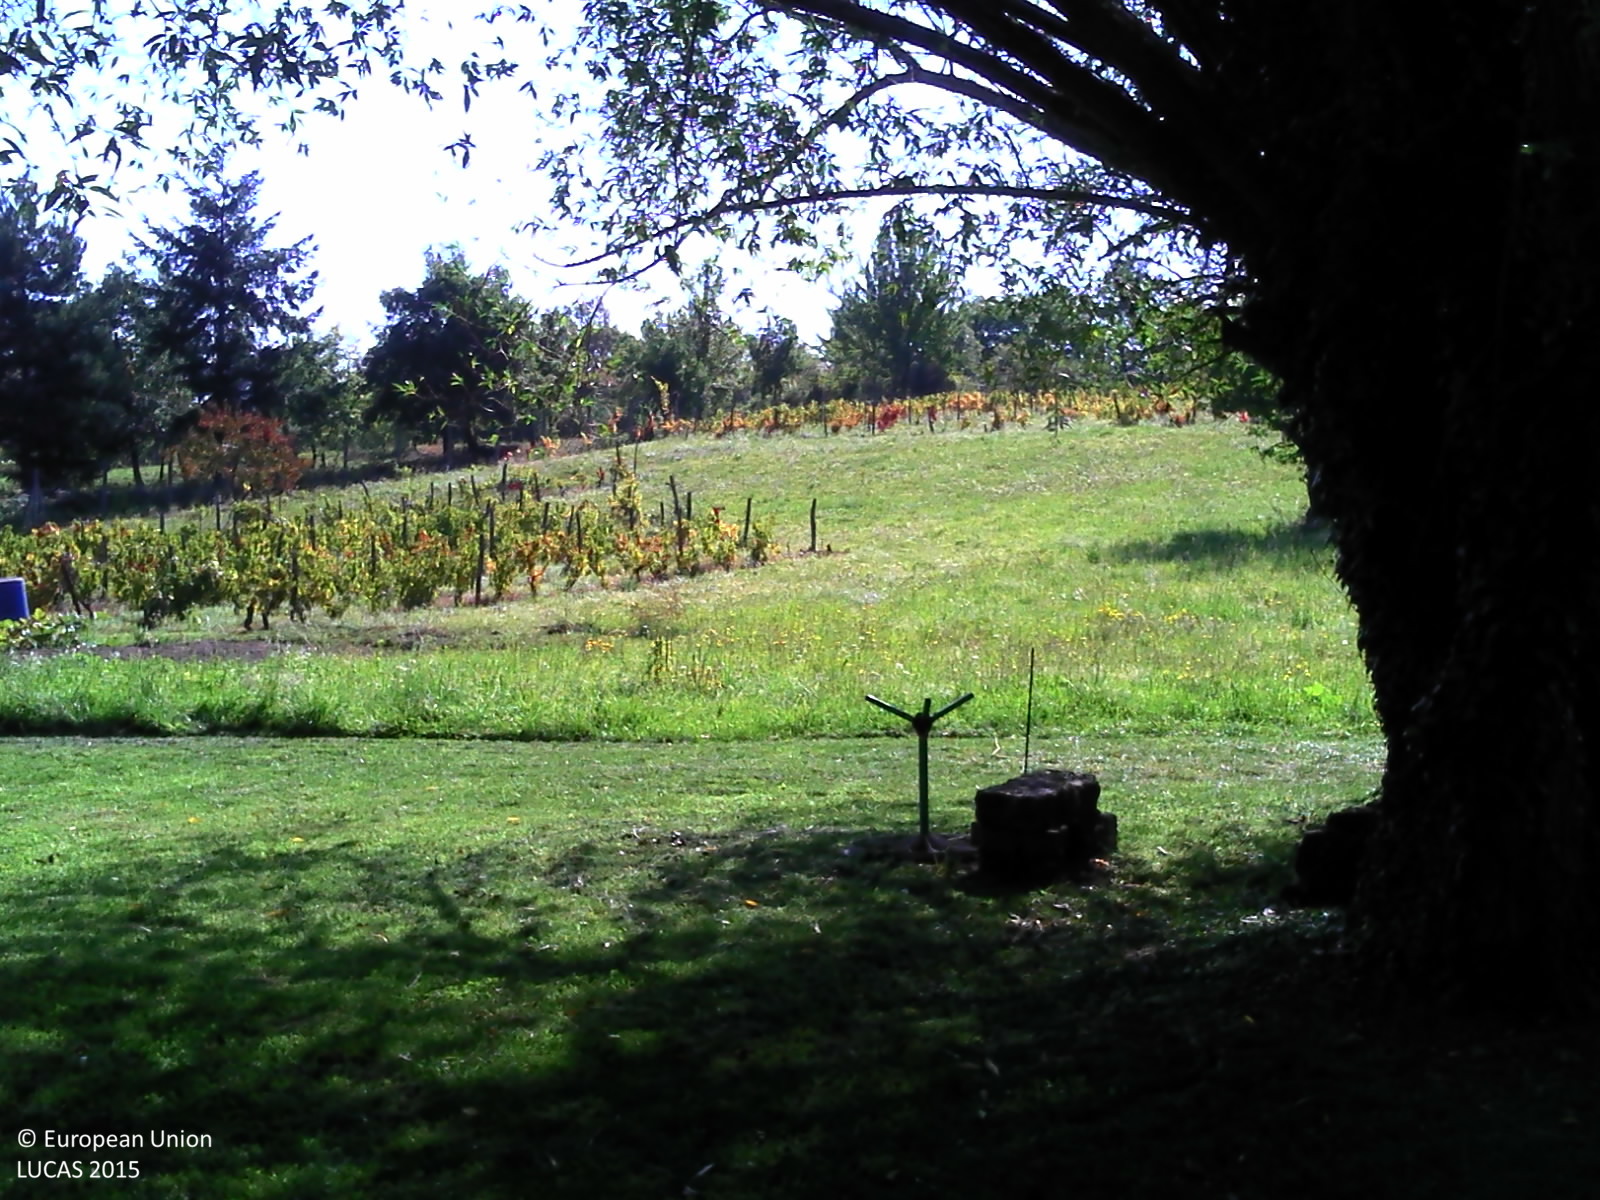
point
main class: Grassland
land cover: Grassland without tree/shrub cover
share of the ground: > 75 %
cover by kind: herbaceous plants 100 %
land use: Agriculture (excluding fallow land and kitchen gardens)
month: October
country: FR
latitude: 45.8902
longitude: 3.0531
